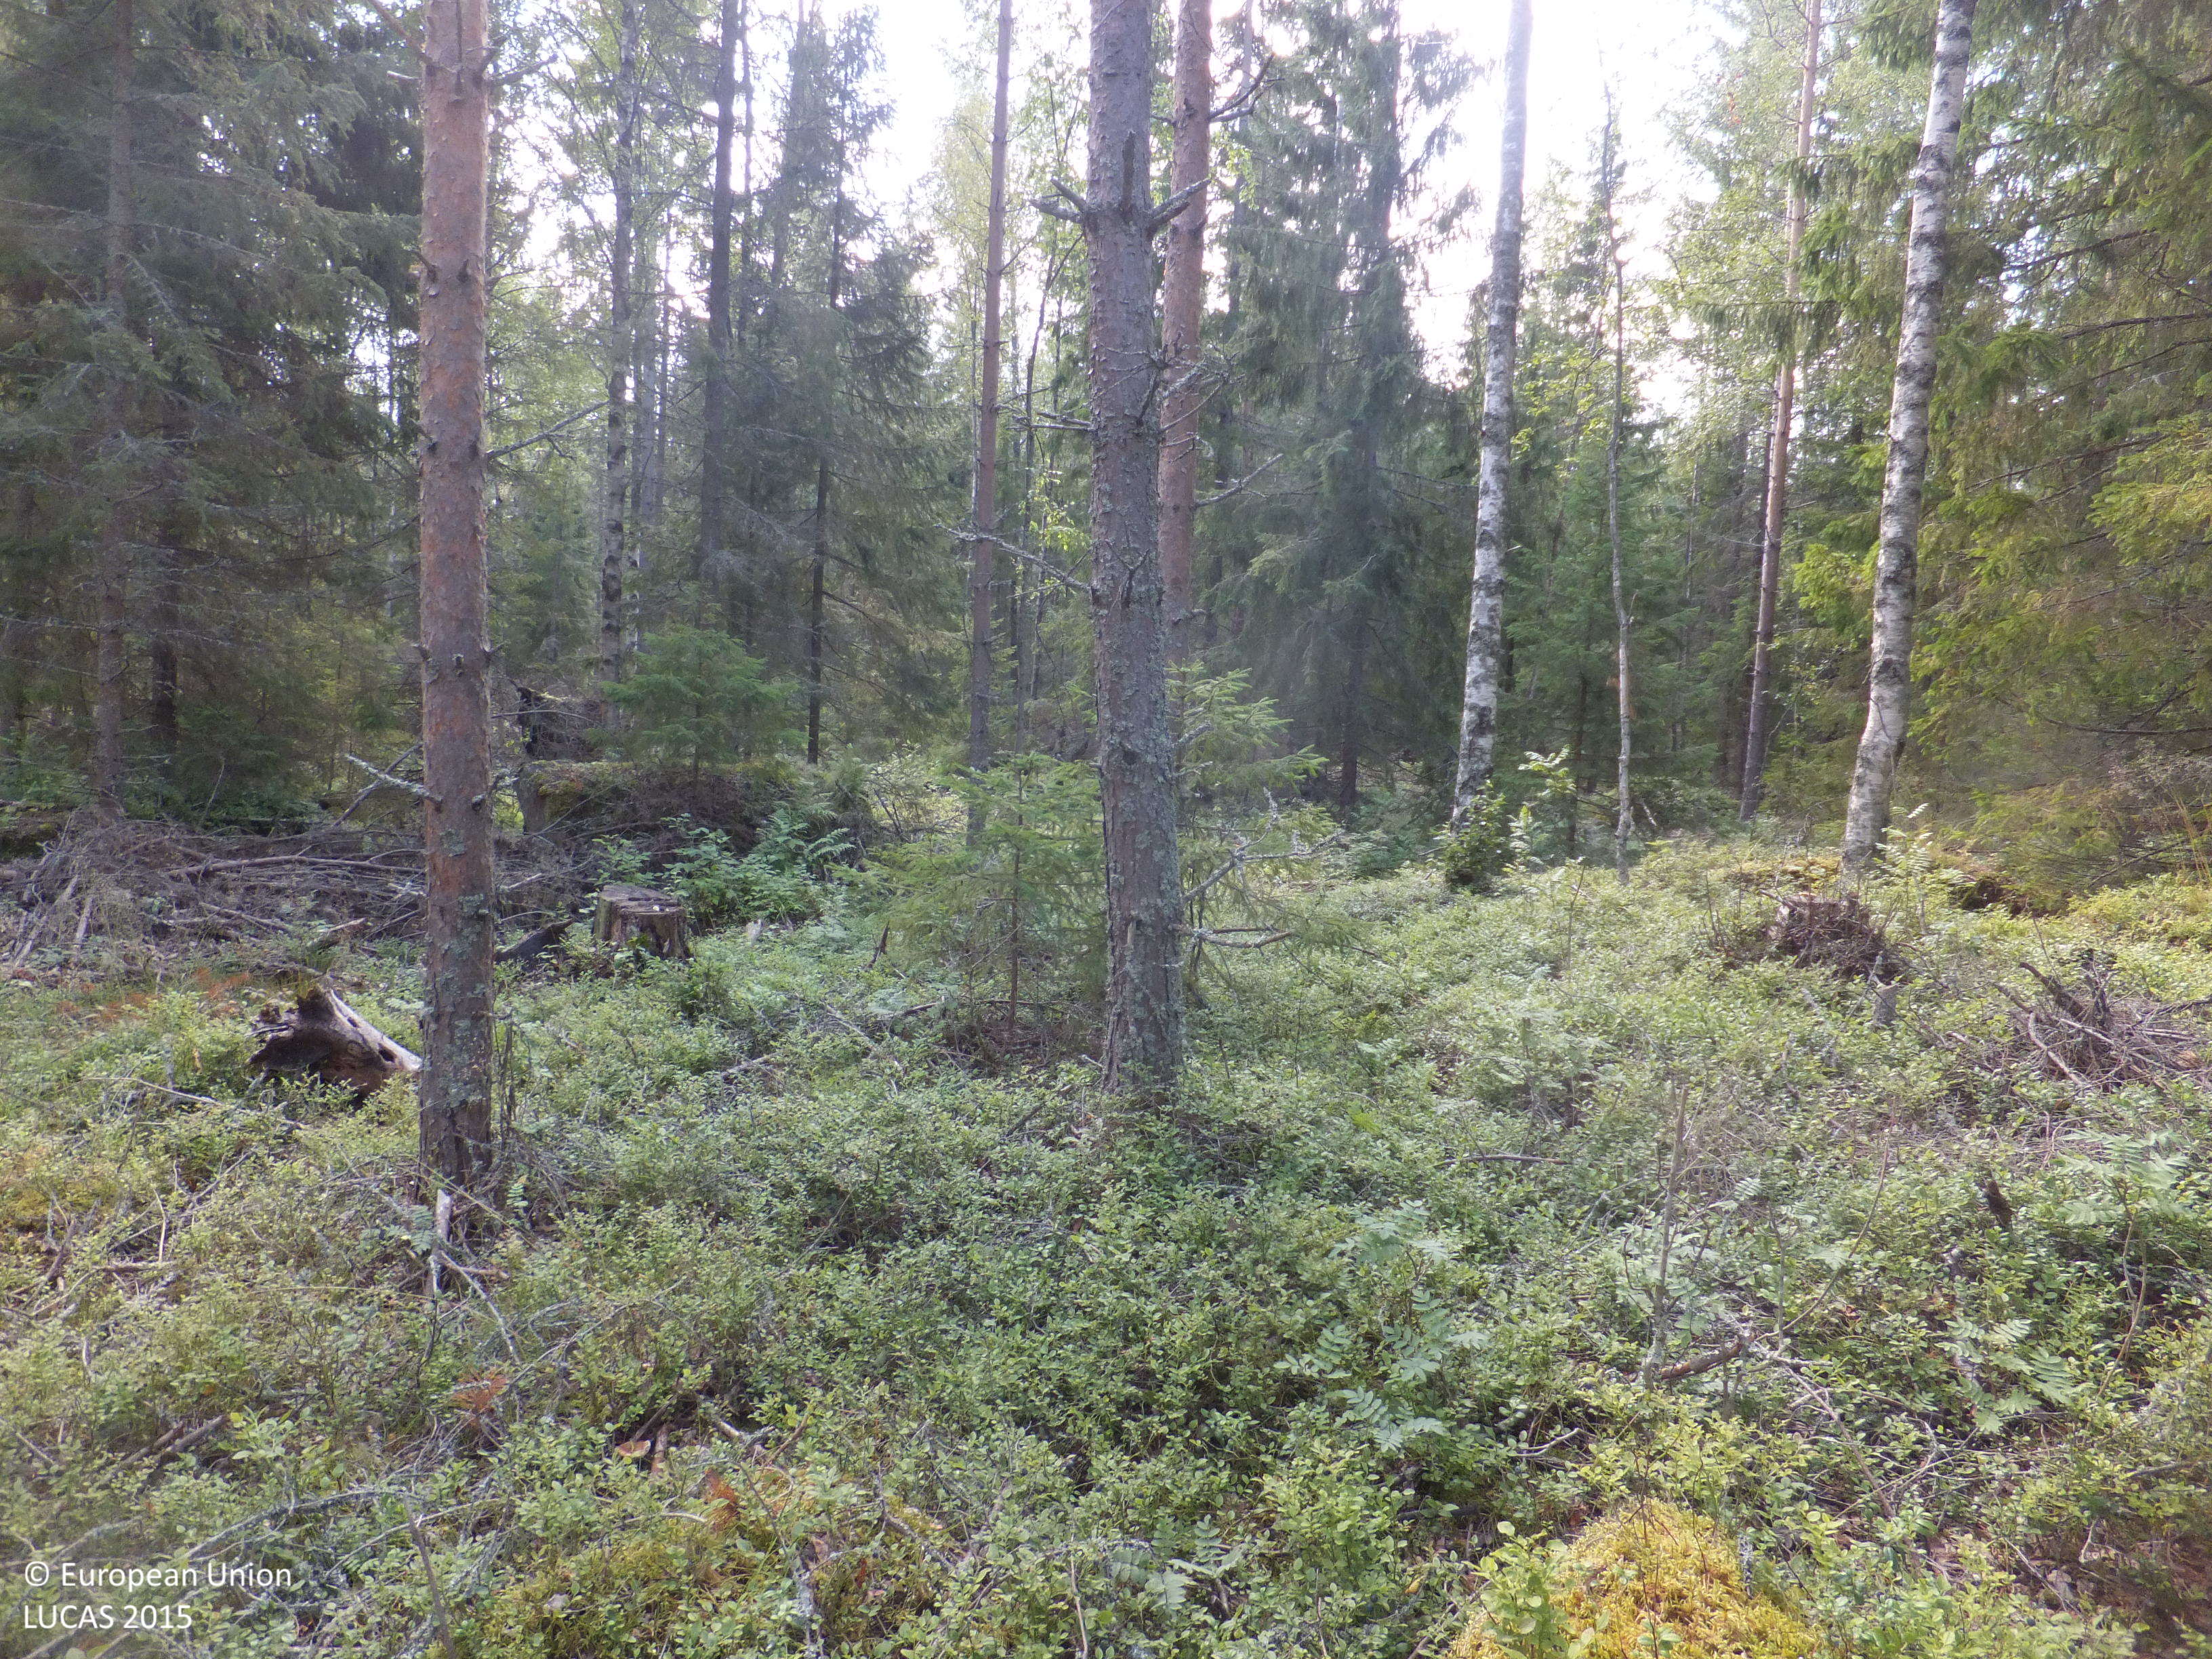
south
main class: Woodland
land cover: Other mixed woodland
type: boreal forest
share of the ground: 50 - 75 %
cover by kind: coniferous forest trees 30 %, broadleaved forest trees 30 %, shrubs 20 %, lichens and mosses 10 %, herbaceous plants 5 %, consolidated bare surface 5 %
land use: Forestry
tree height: > 5 m
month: July
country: FI
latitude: 63.3514
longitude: 22.0534
